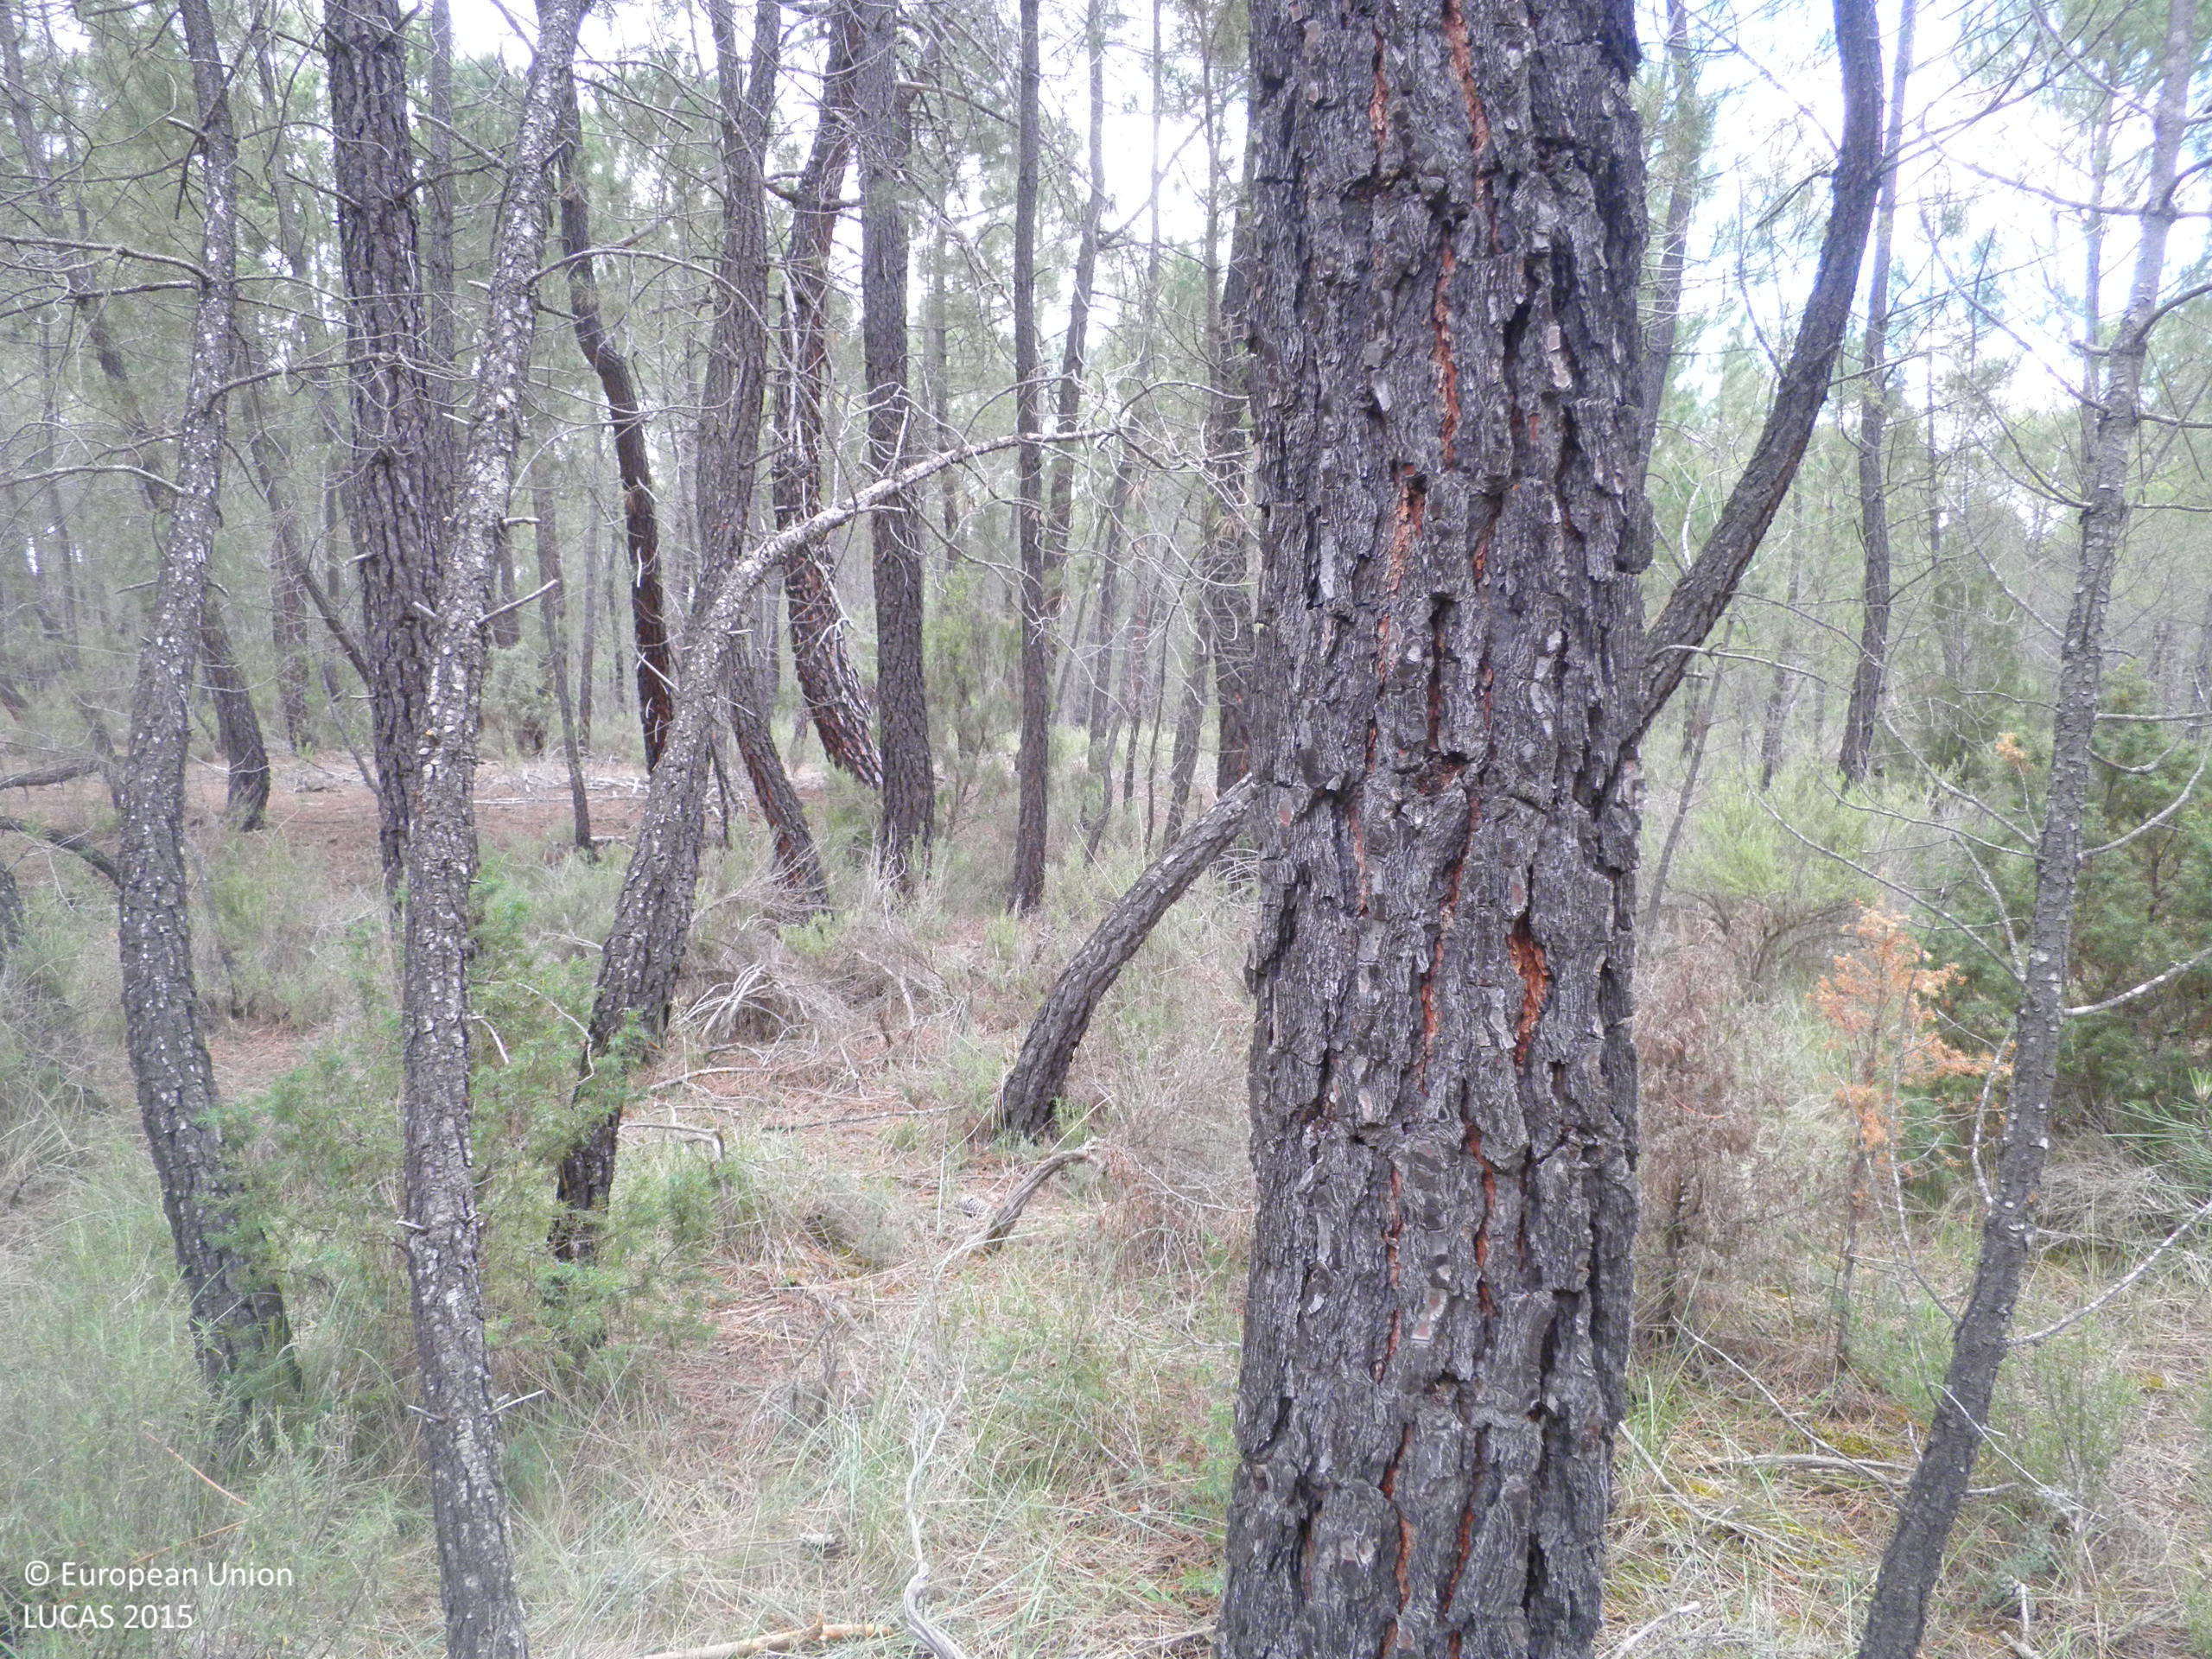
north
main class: Woodland
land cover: Pine dominated coniferous woodland
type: coniferous forest of the mediterranean region
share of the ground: 50 - 75 %
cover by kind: coniferous forest trees 60 %, herbaceous plants 20 %, shrubs 10 %, consolidated bare surface 10 %
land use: Semi-natural and natural areas not in use
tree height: > 5 m
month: June
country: ES
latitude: 39.7898
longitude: -1.6510
